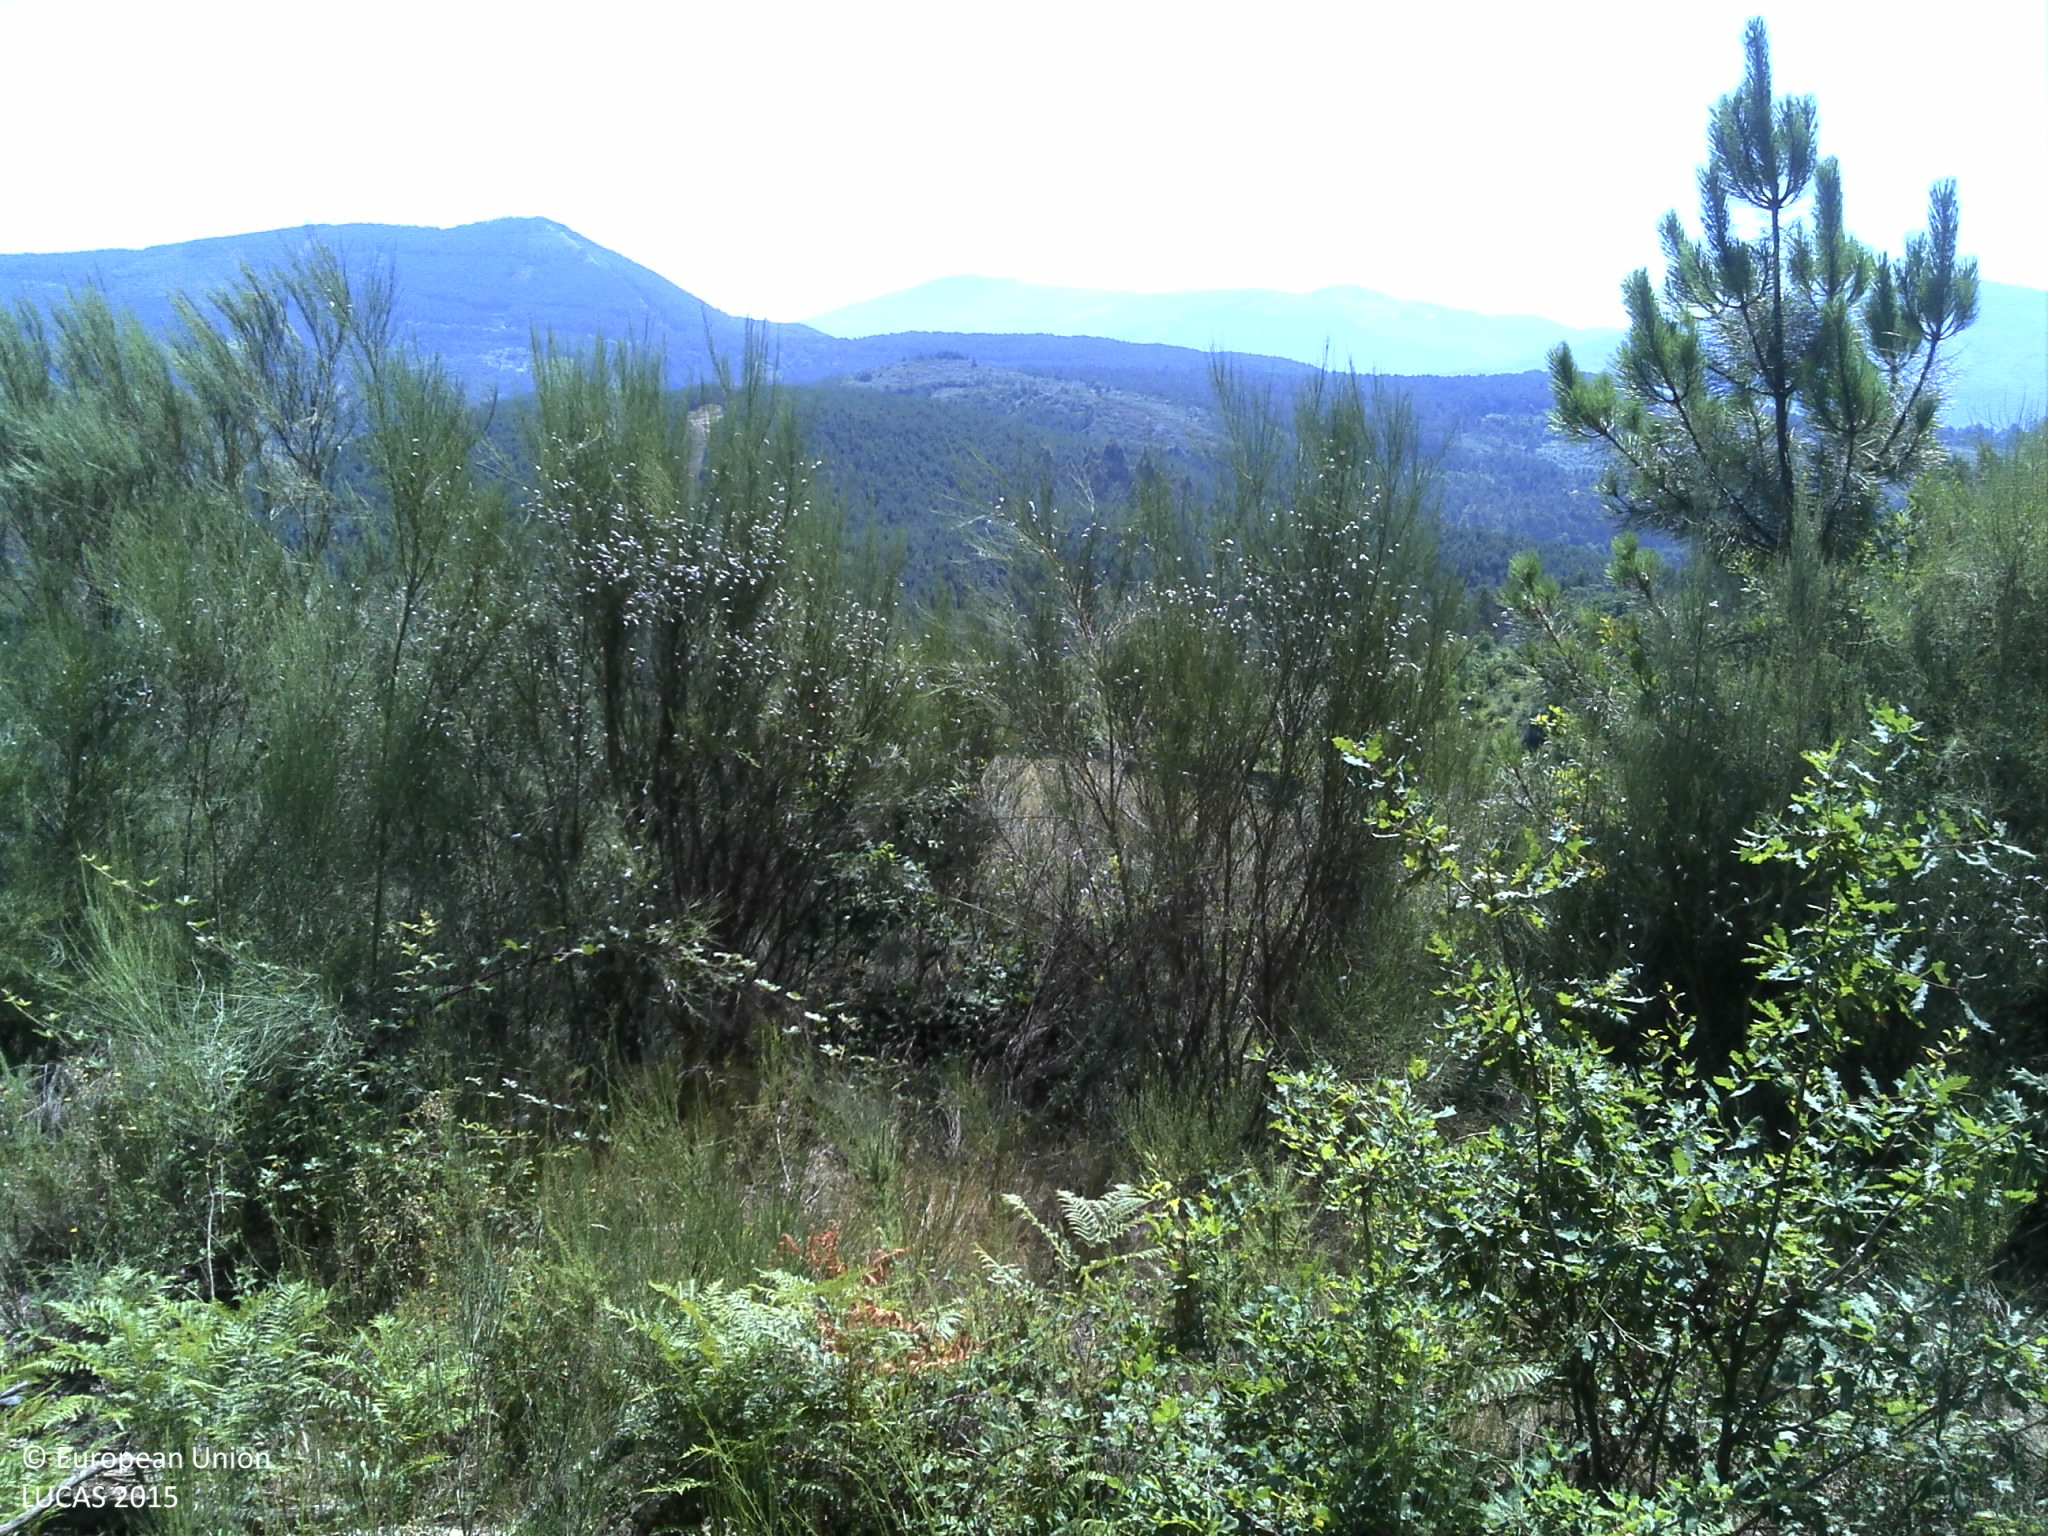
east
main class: Woodland
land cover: Pine dominated coniferous woodland
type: coniferous forest of the mediterranean region
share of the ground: 50 - 75 %
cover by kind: coniferous forest trees 65 %, shrubs 30 %, unconsolidated bare surface 5 %
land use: Semi-natural and natural areas not in use
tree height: > 5 m
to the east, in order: Pine dominated coniferous woodland; Shrubland with sparse tree cover; Paved roads, cycling and walking lanes; Shrubland without tree cover; Tracks; Dry stone walls; Vineyards; Grassland without tree/shrub cover; Vineyards; Dry stone walls; Grassland without tree/shrub cover; Vineyards; Grassland without tree/shrub cover; Vineyards; Dry stone walls; Grassland without tree/shrub cover; Vineyards; Dry stone walls; Vineyards; Broadleaved woodland; Grassland without tree/shrub cover; Vineyards; Grassland without tree/shrub cover; Dry stone walls; Vineyards; Grassland without tree/shrub cover
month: July
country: PT
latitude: 41.5523
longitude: -7.8453
